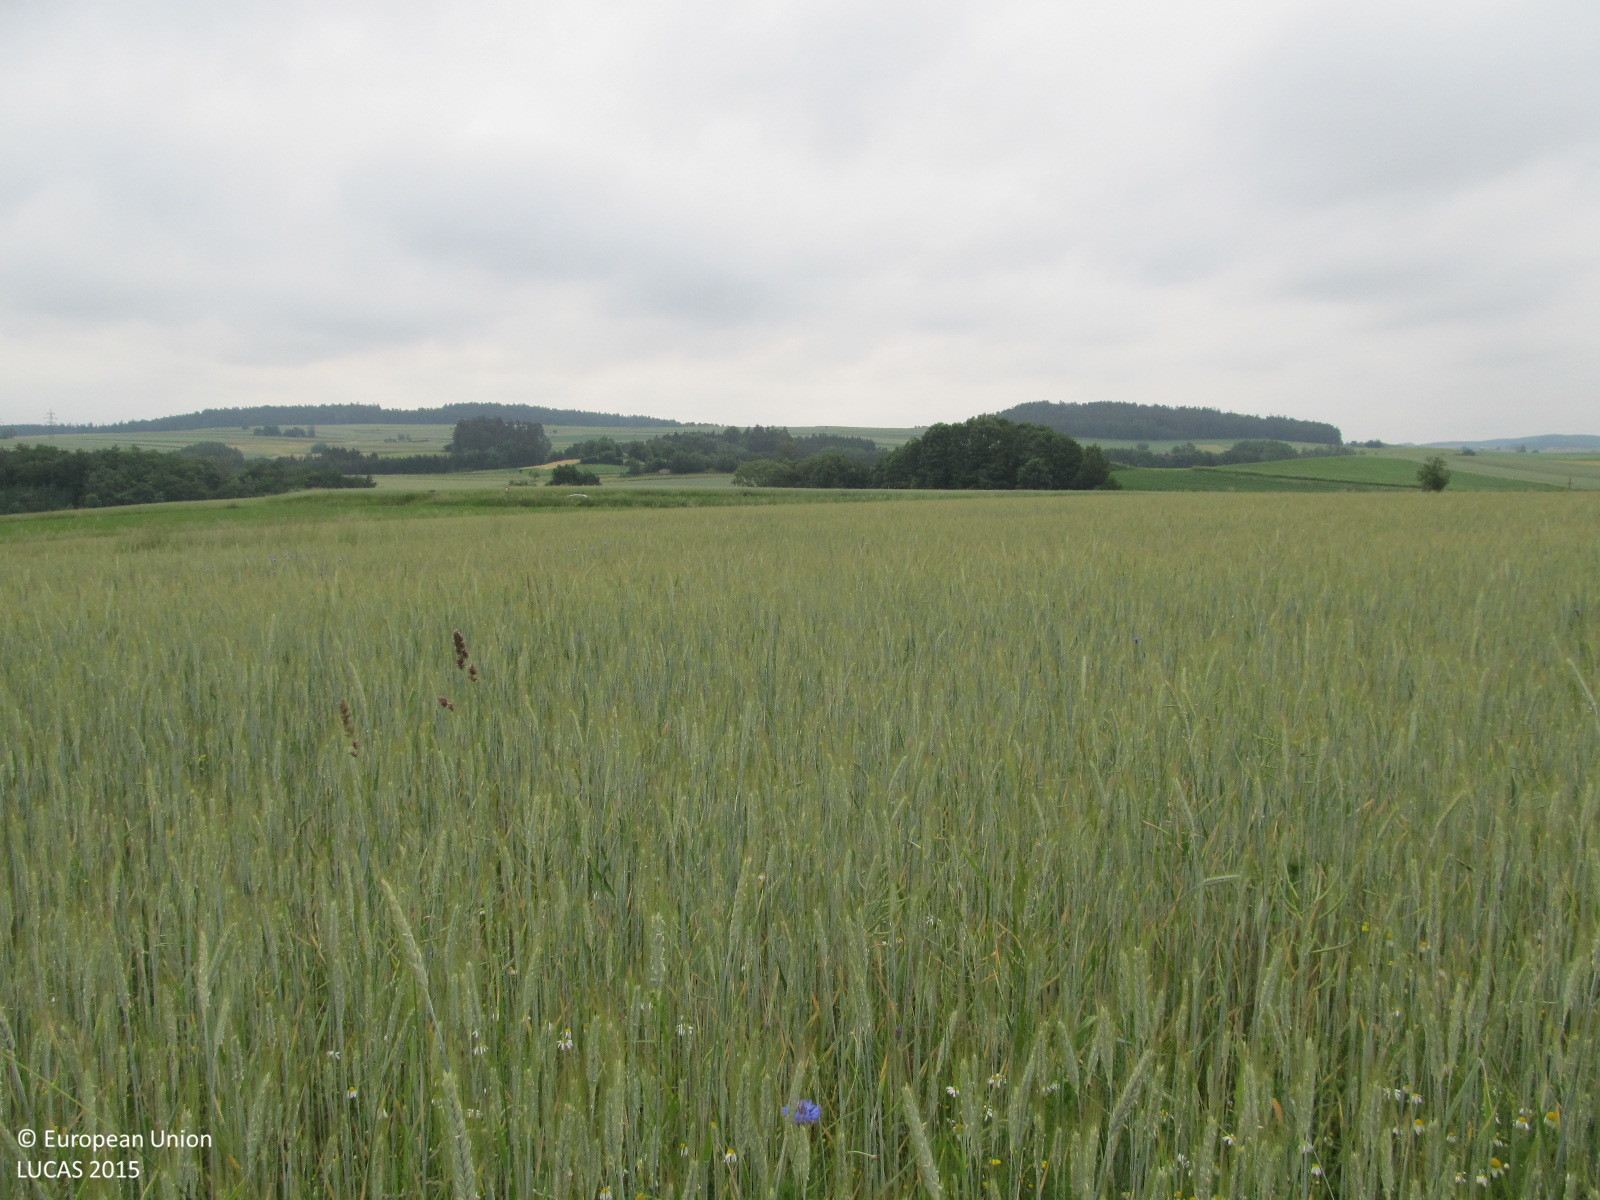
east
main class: Cropland
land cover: Rye
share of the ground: > 75 %
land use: Agriculture (excluding fallow land and kitchen gardens)
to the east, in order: Rye; Grass margins; Common wheat; Grass margins; Maize; Grass margins; Tracks; Temporary grasslands; Grass margins; Paved roads, cycling and walking lanes; Grass margins; Temporary grasslands; Dry pulses
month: June
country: AT
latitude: 48.5749
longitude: 15.4649
